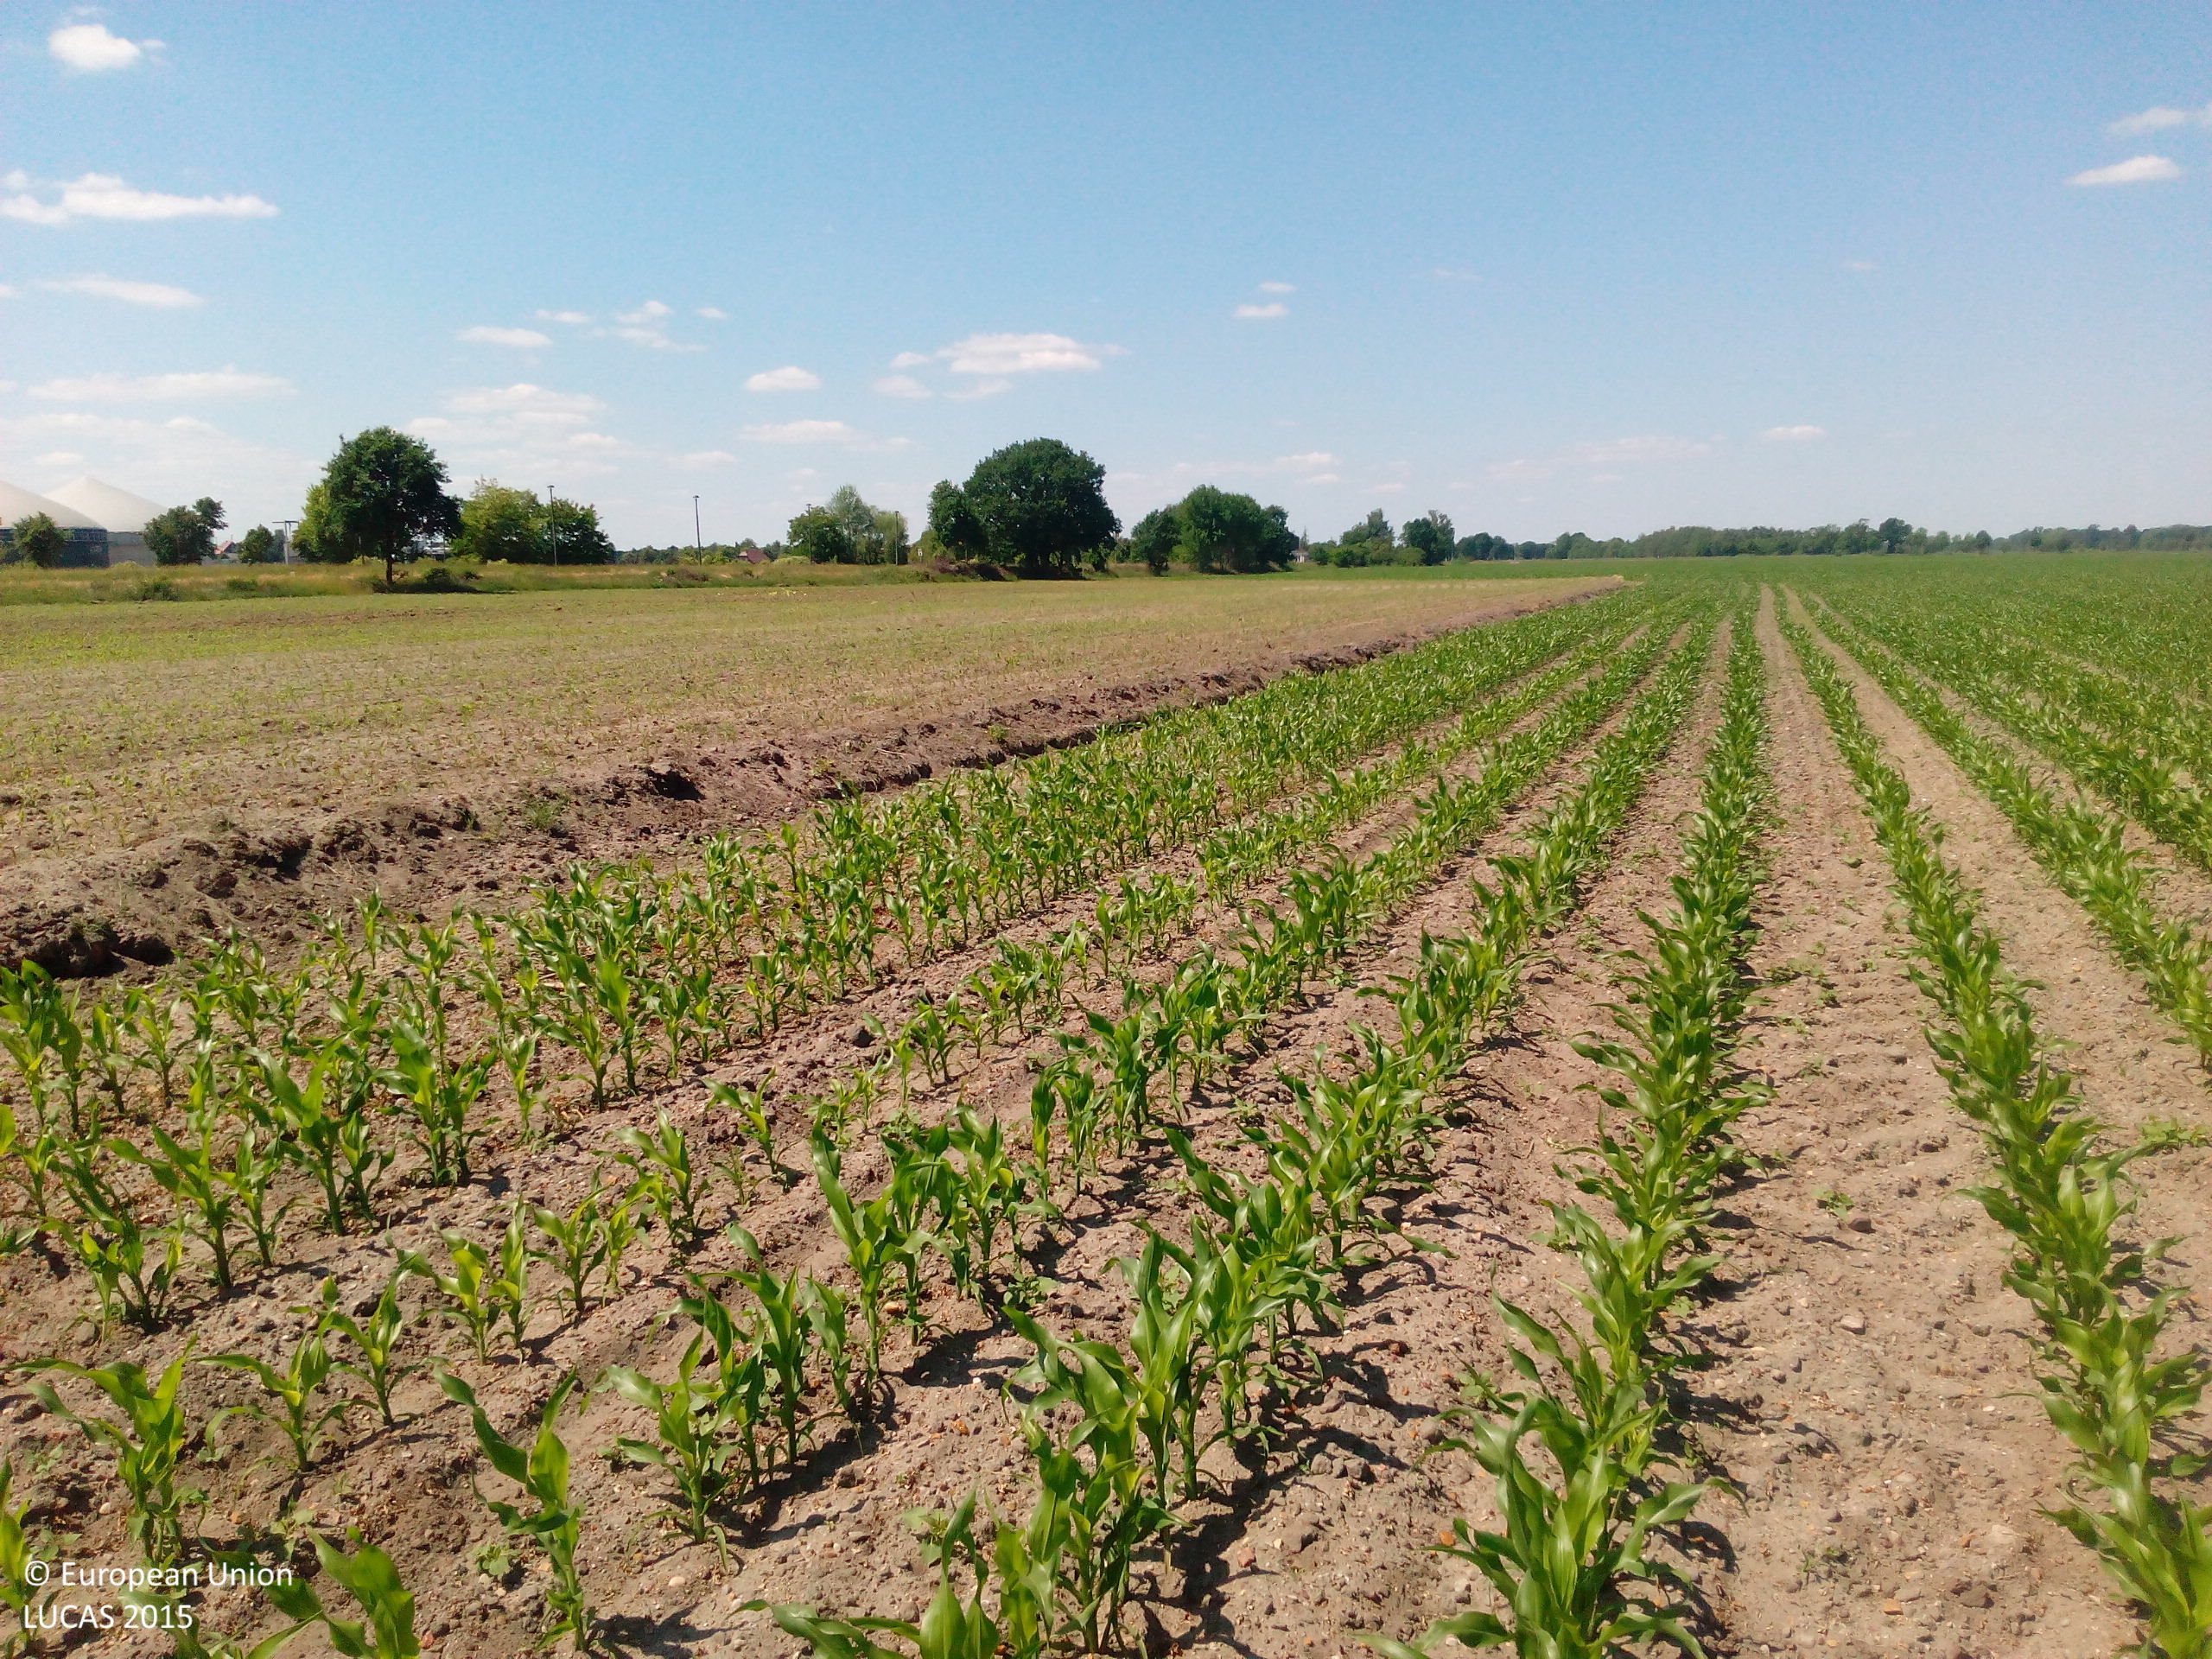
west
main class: Cropland
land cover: Maize
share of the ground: 10 - 25 %
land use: Agriculture (excluding fallow land and kitchen gardens)
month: June
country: DE
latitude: 52.4080
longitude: 11.1315
